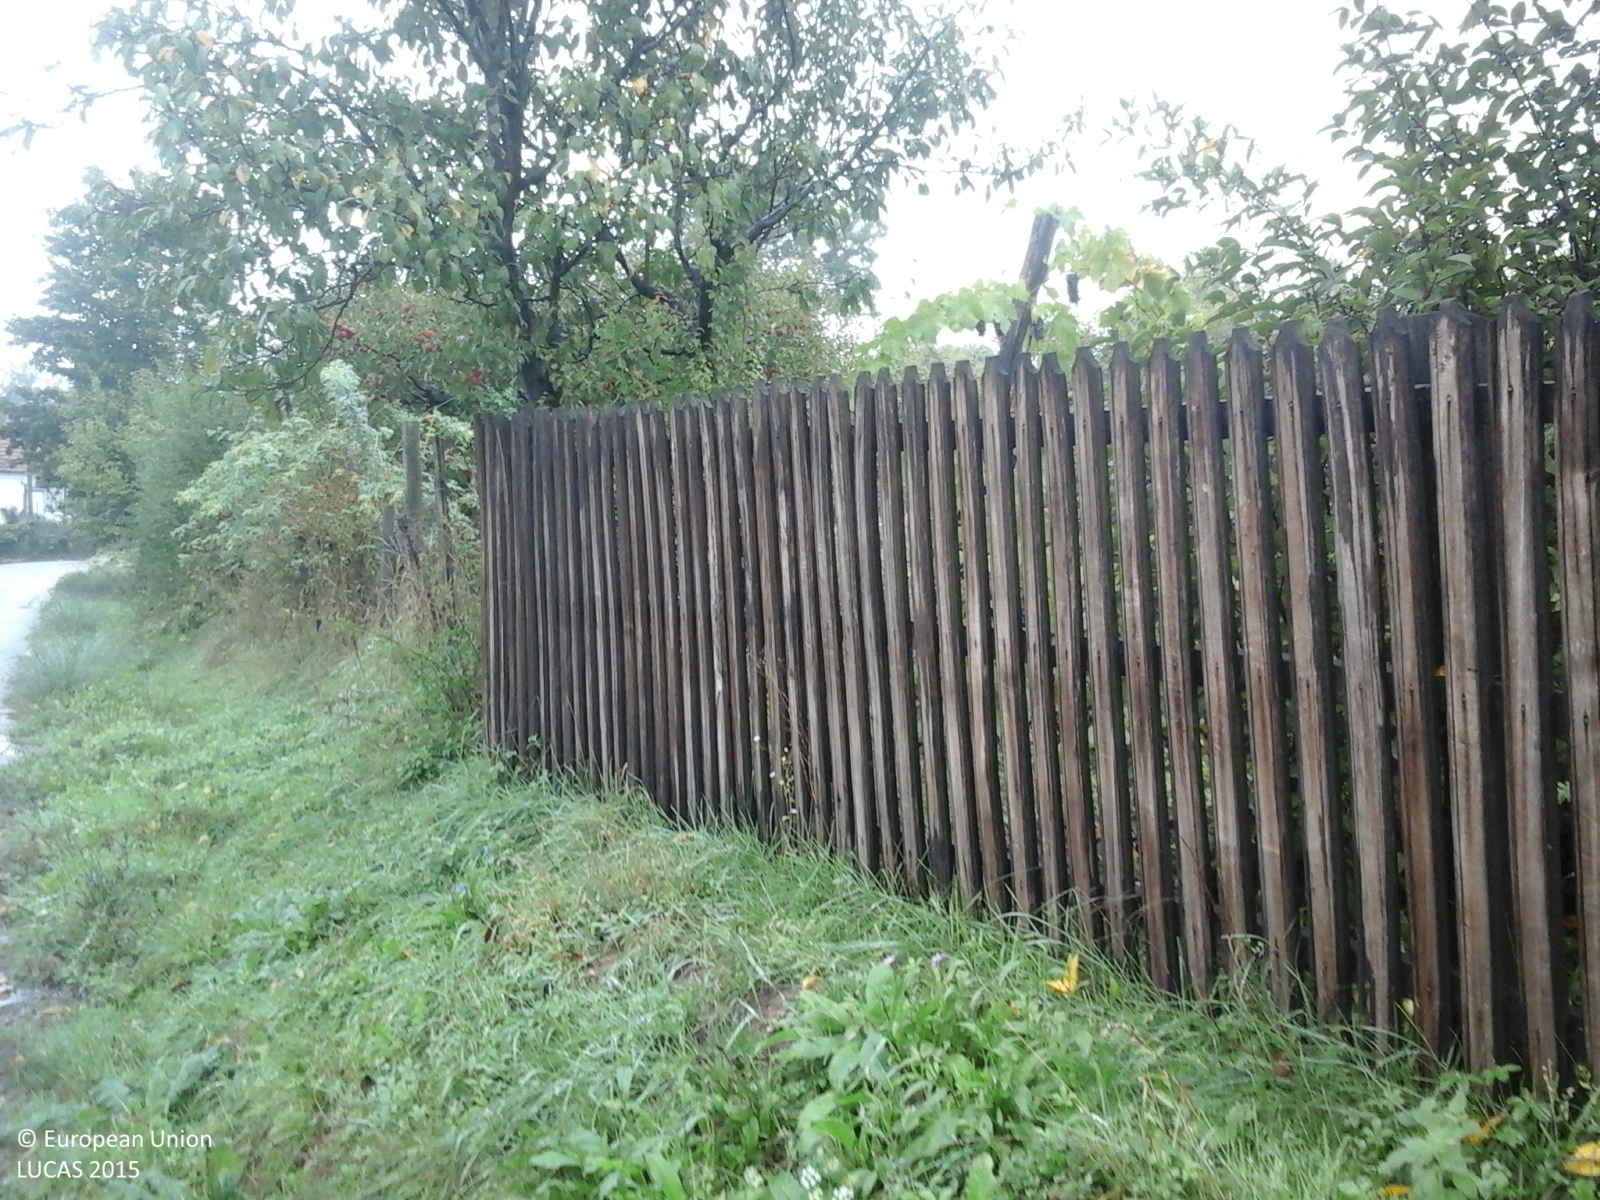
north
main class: Cropland
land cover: Apple fruit
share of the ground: 50 - 75 %
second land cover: Grassland without tree/shrub cover
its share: > 75 %
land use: Agriculture (excluding fallow land and kitchen gardens)
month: September
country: RO
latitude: 45.1129
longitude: 24.0109
